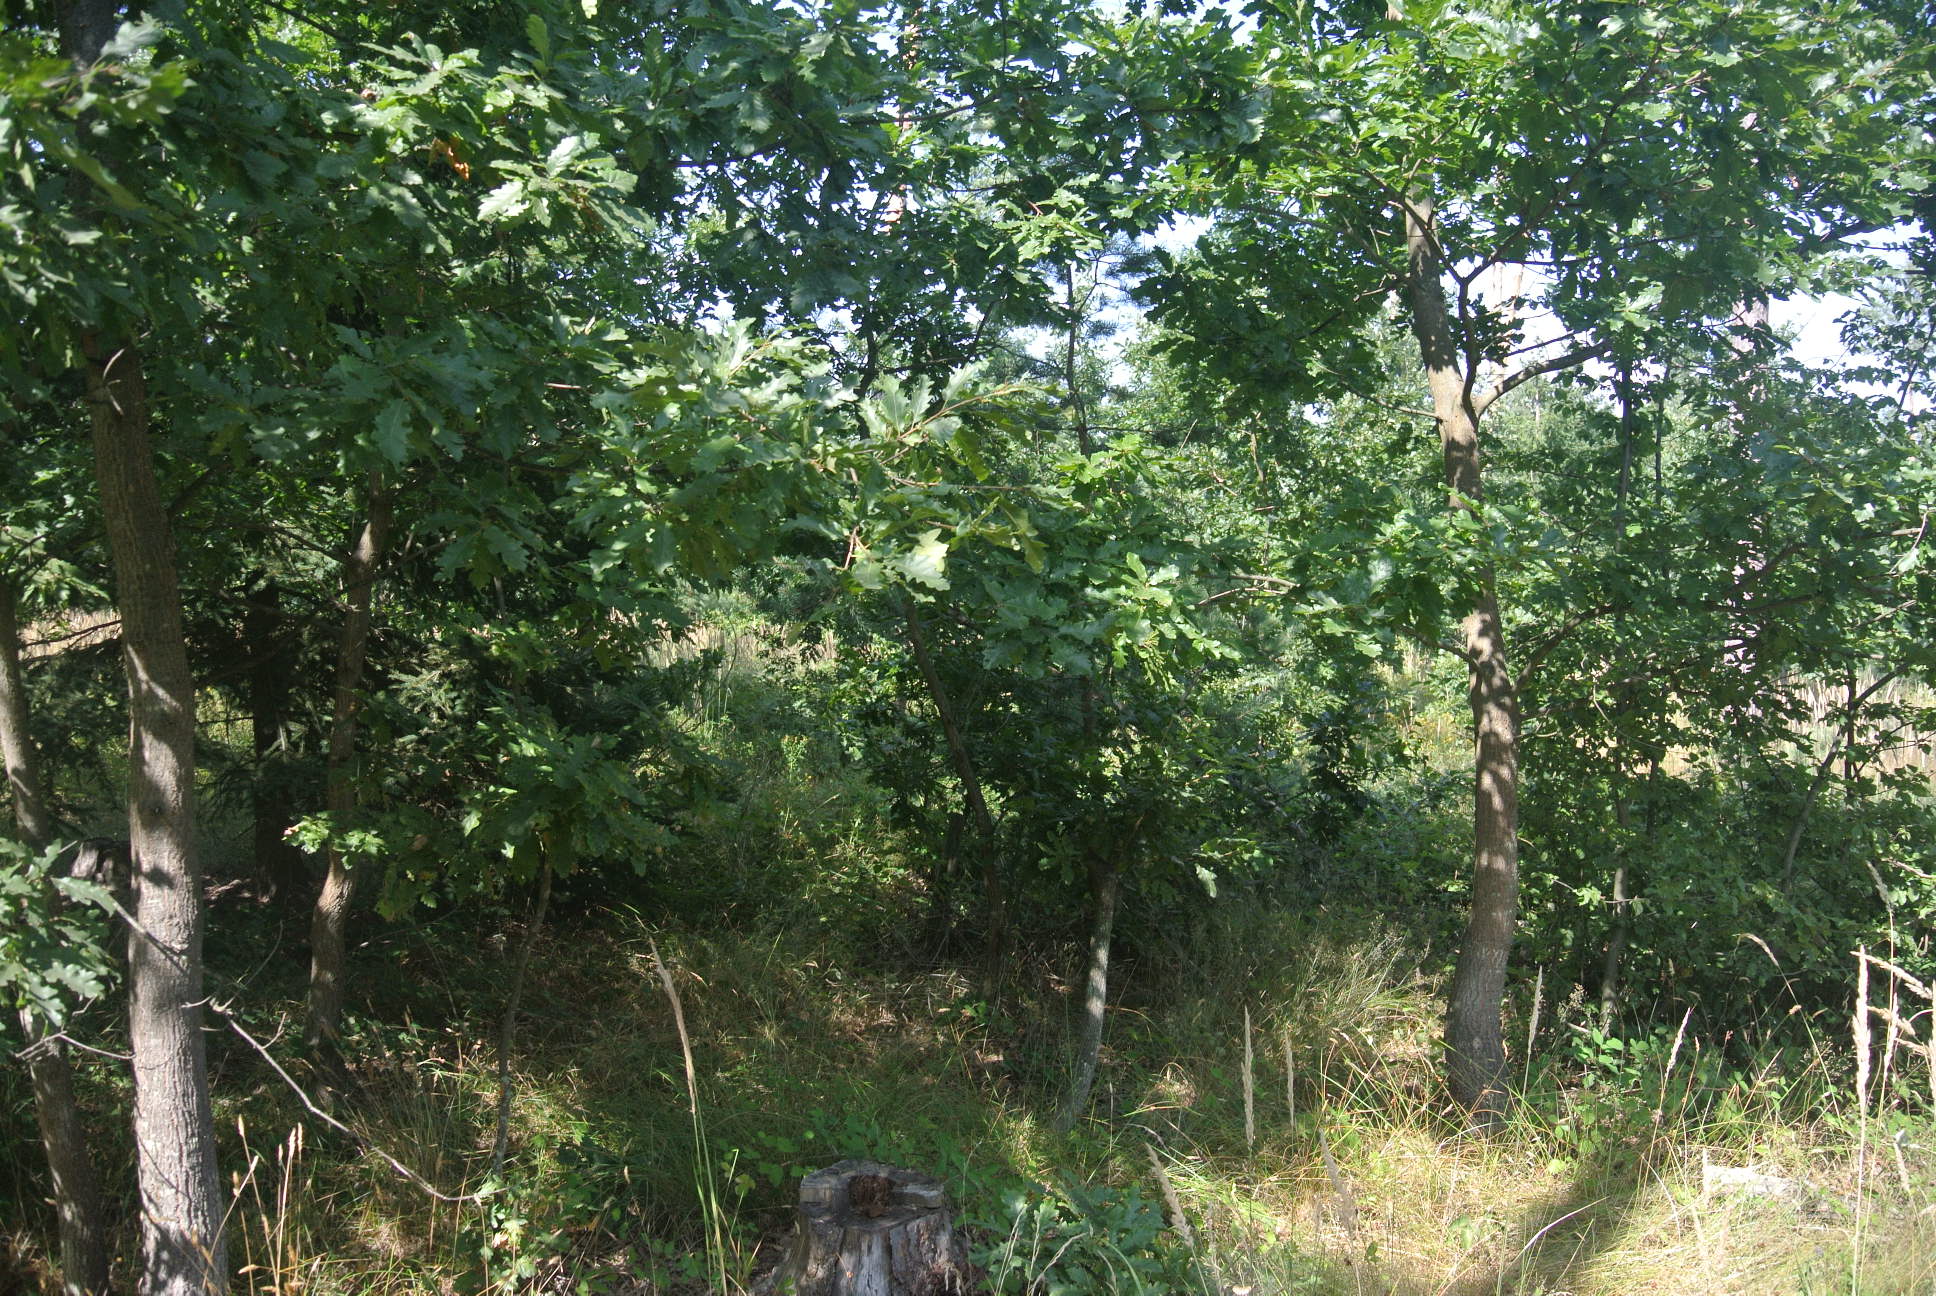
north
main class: Woodland
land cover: Pine dominated mixed woodland
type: acidophilous oak and oak-birch forest
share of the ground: > 75 %
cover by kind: coniferous forest trees 40 %, broadleaved forest trees 35 %, herbaceous plants 25 %
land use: Forestry
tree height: > 5 m
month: July
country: AT
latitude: 47.5442
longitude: 16.5009
